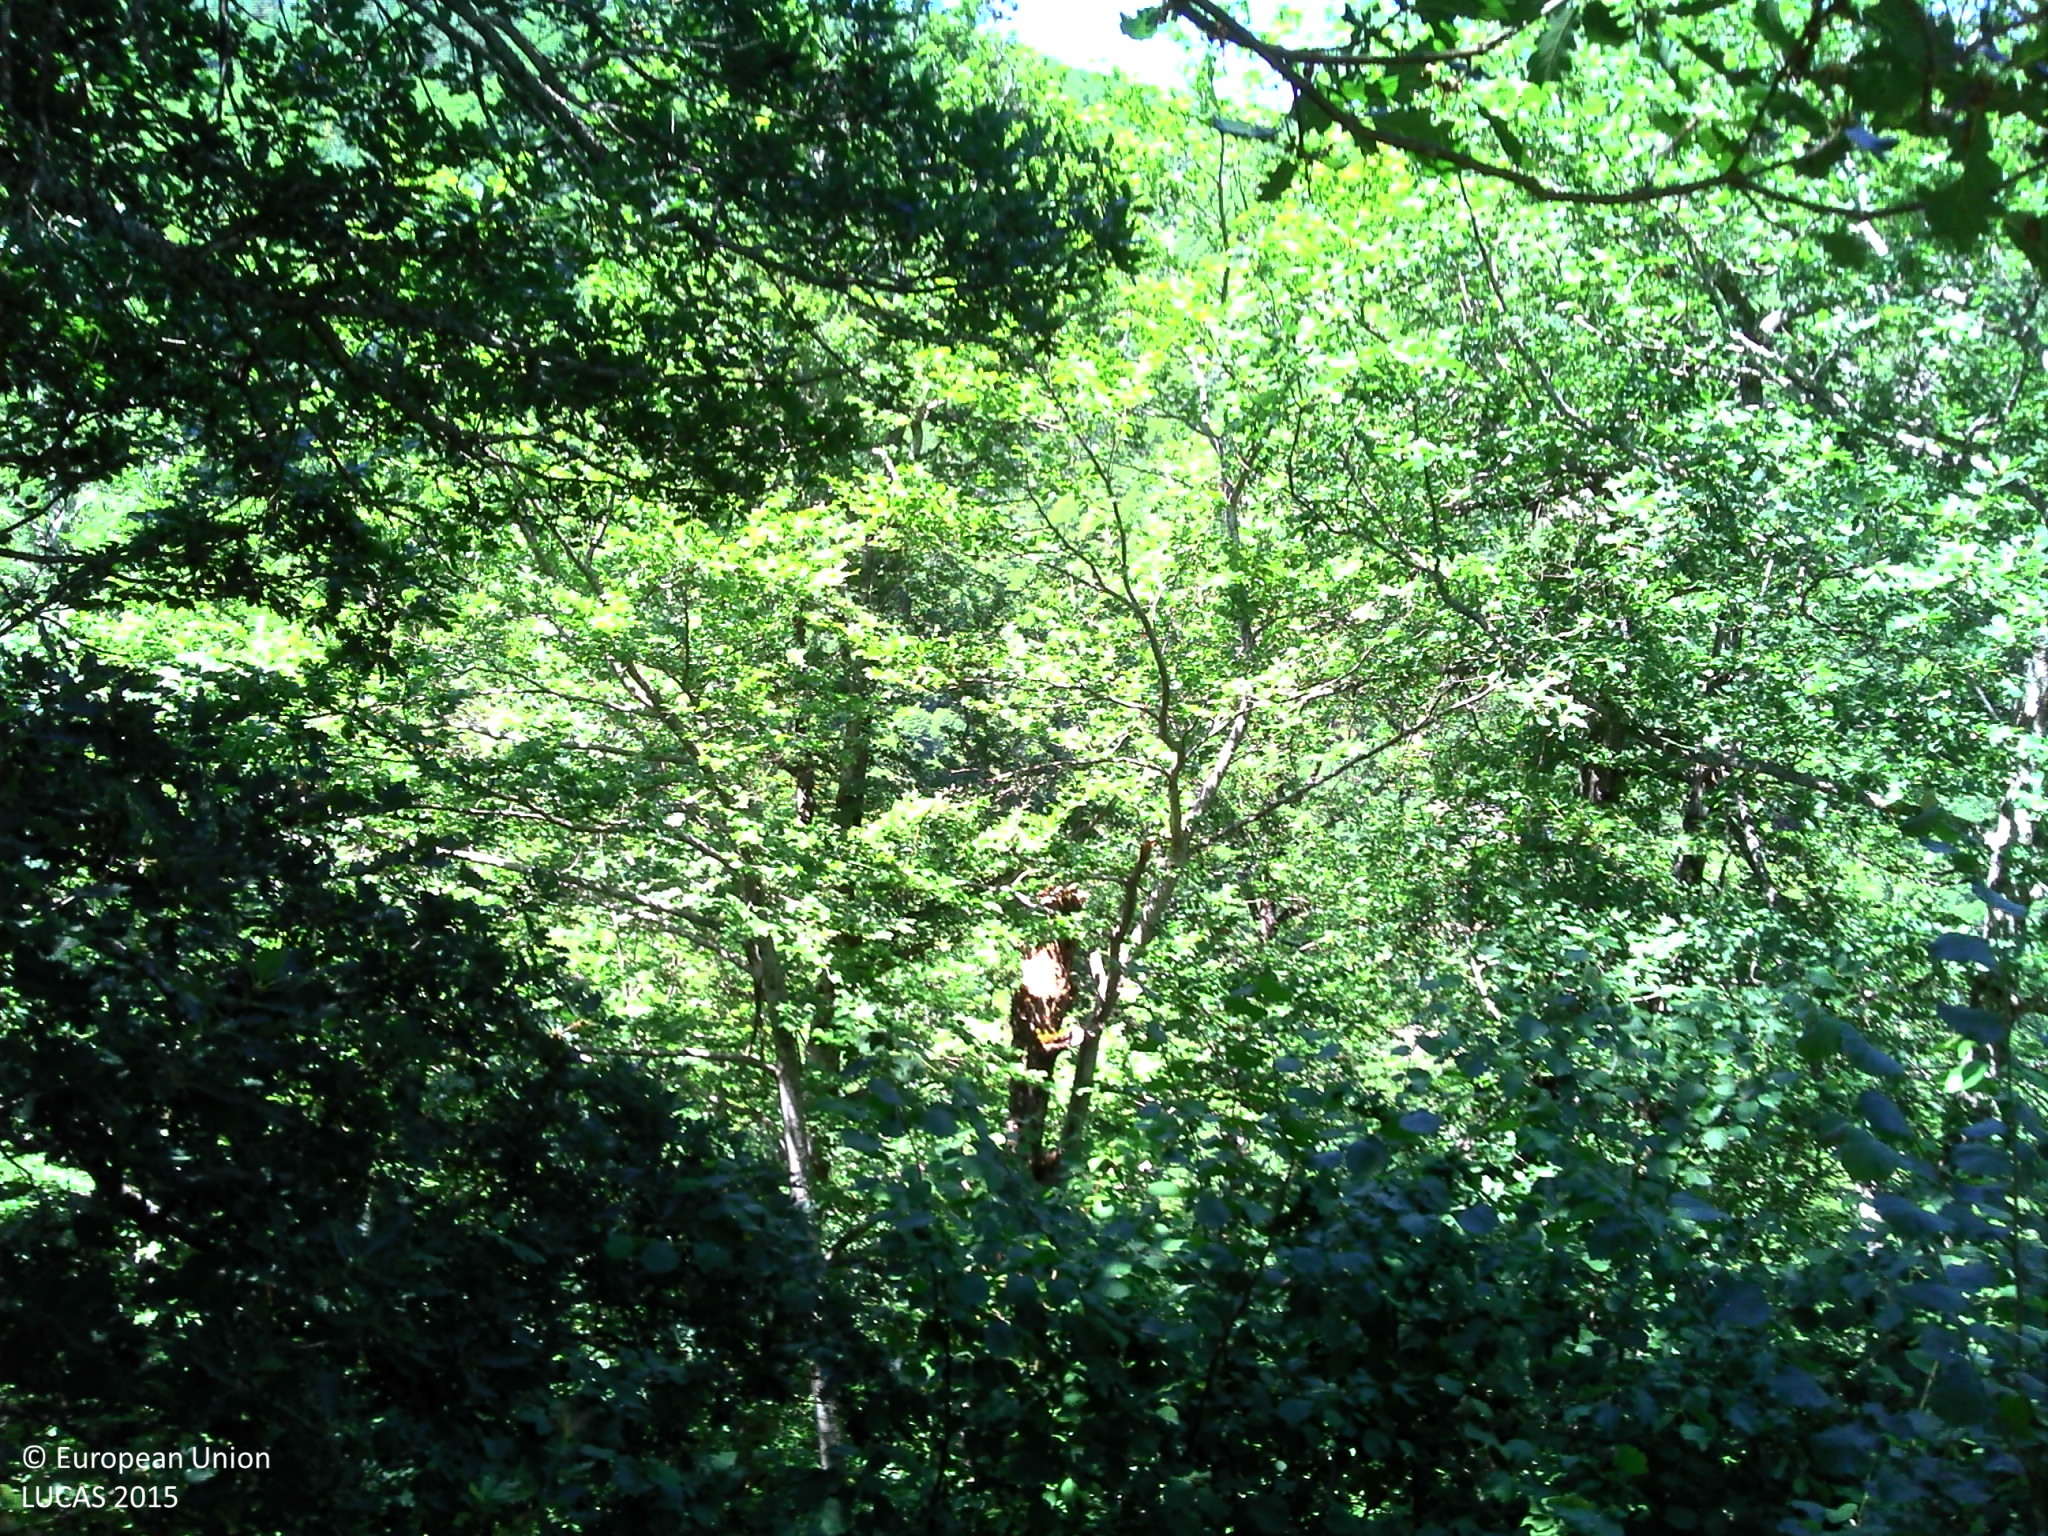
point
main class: Woodland
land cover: Broadleaved woodland
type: mesophytic deciduous forest
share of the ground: > 75 %
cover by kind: broadleaved forest trees 100 %
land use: Semi-natural and natural areas not in use
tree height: > 5 m
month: July
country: FR
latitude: 42.6926
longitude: 2.1373
